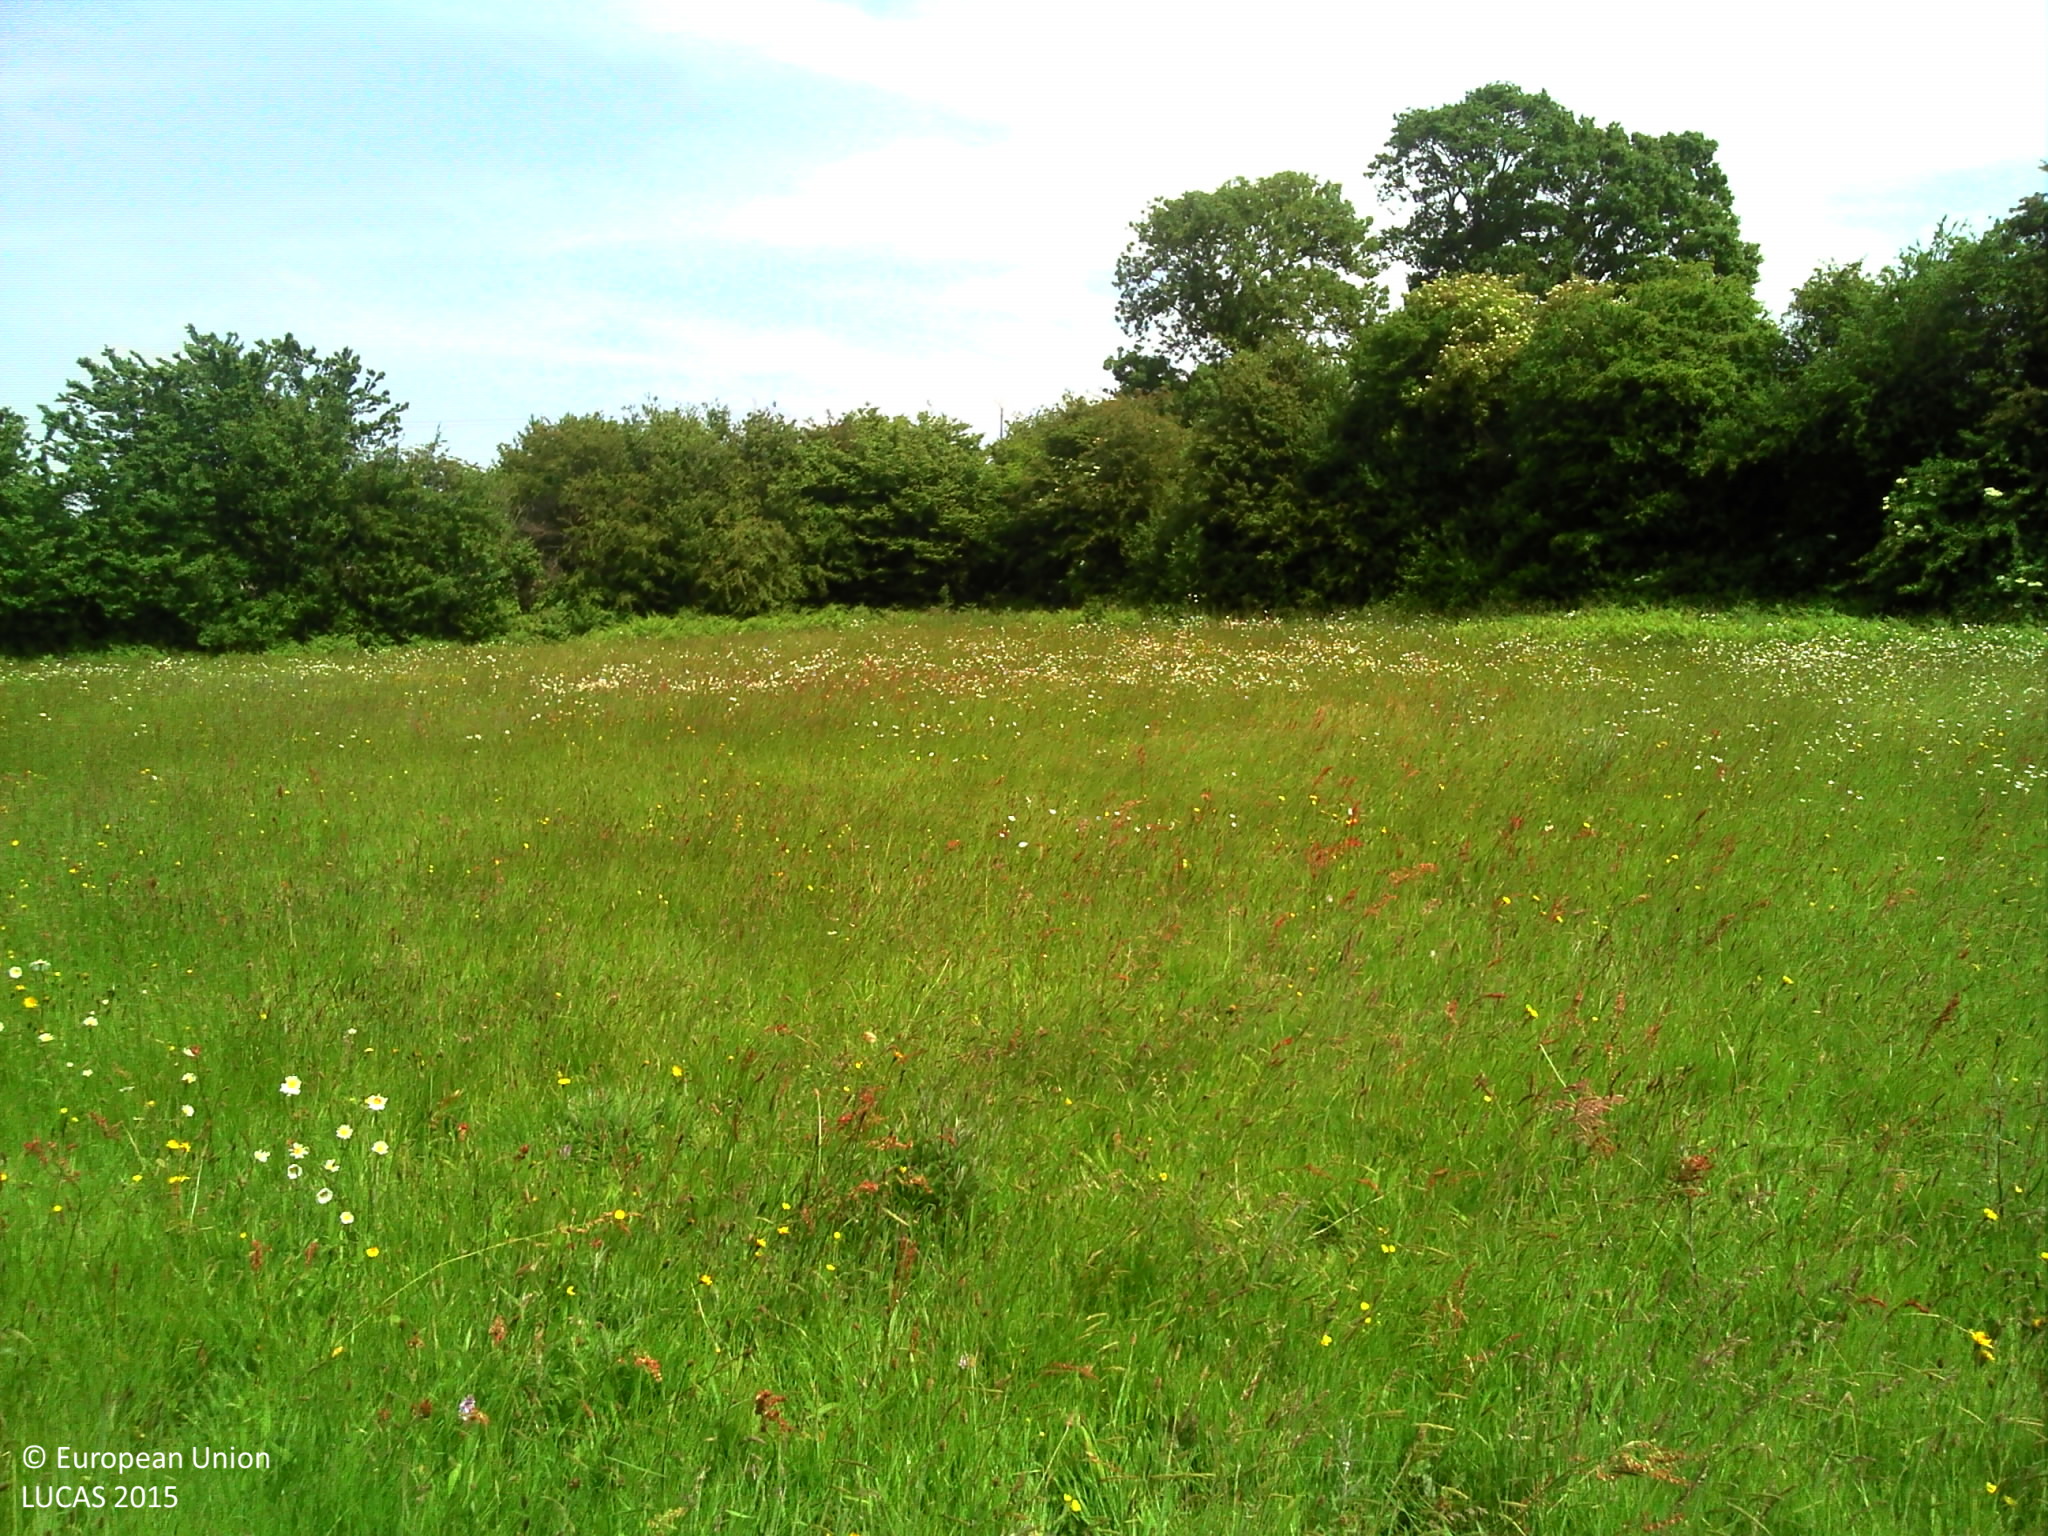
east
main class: Grassland
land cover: Grassland without tree/shrub cover
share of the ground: > 75 %
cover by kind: herbaceous plants 100 %
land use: Agriculture (excluding fallow land and kitchen gardens)
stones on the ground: < 10 %
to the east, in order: Grassland without tree/shrub cover; Broadleaved woodland; Grassland without tree/shrub cover; Broadleaved woodland; Spontaneously vegetated surfaces; Electric lines; Spontaneously vegetated surfaces; Grass margins; Paved roads, cycling and walking lanes; Grass margins; Abandoned hedges; Grassland without tree/shrub cover; Abandoned hedges; Grassland with sparse tree/shrub cover; Paved roads, cycling and walking lanes
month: June
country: FR
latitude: 49.4945
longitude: -1.4669
